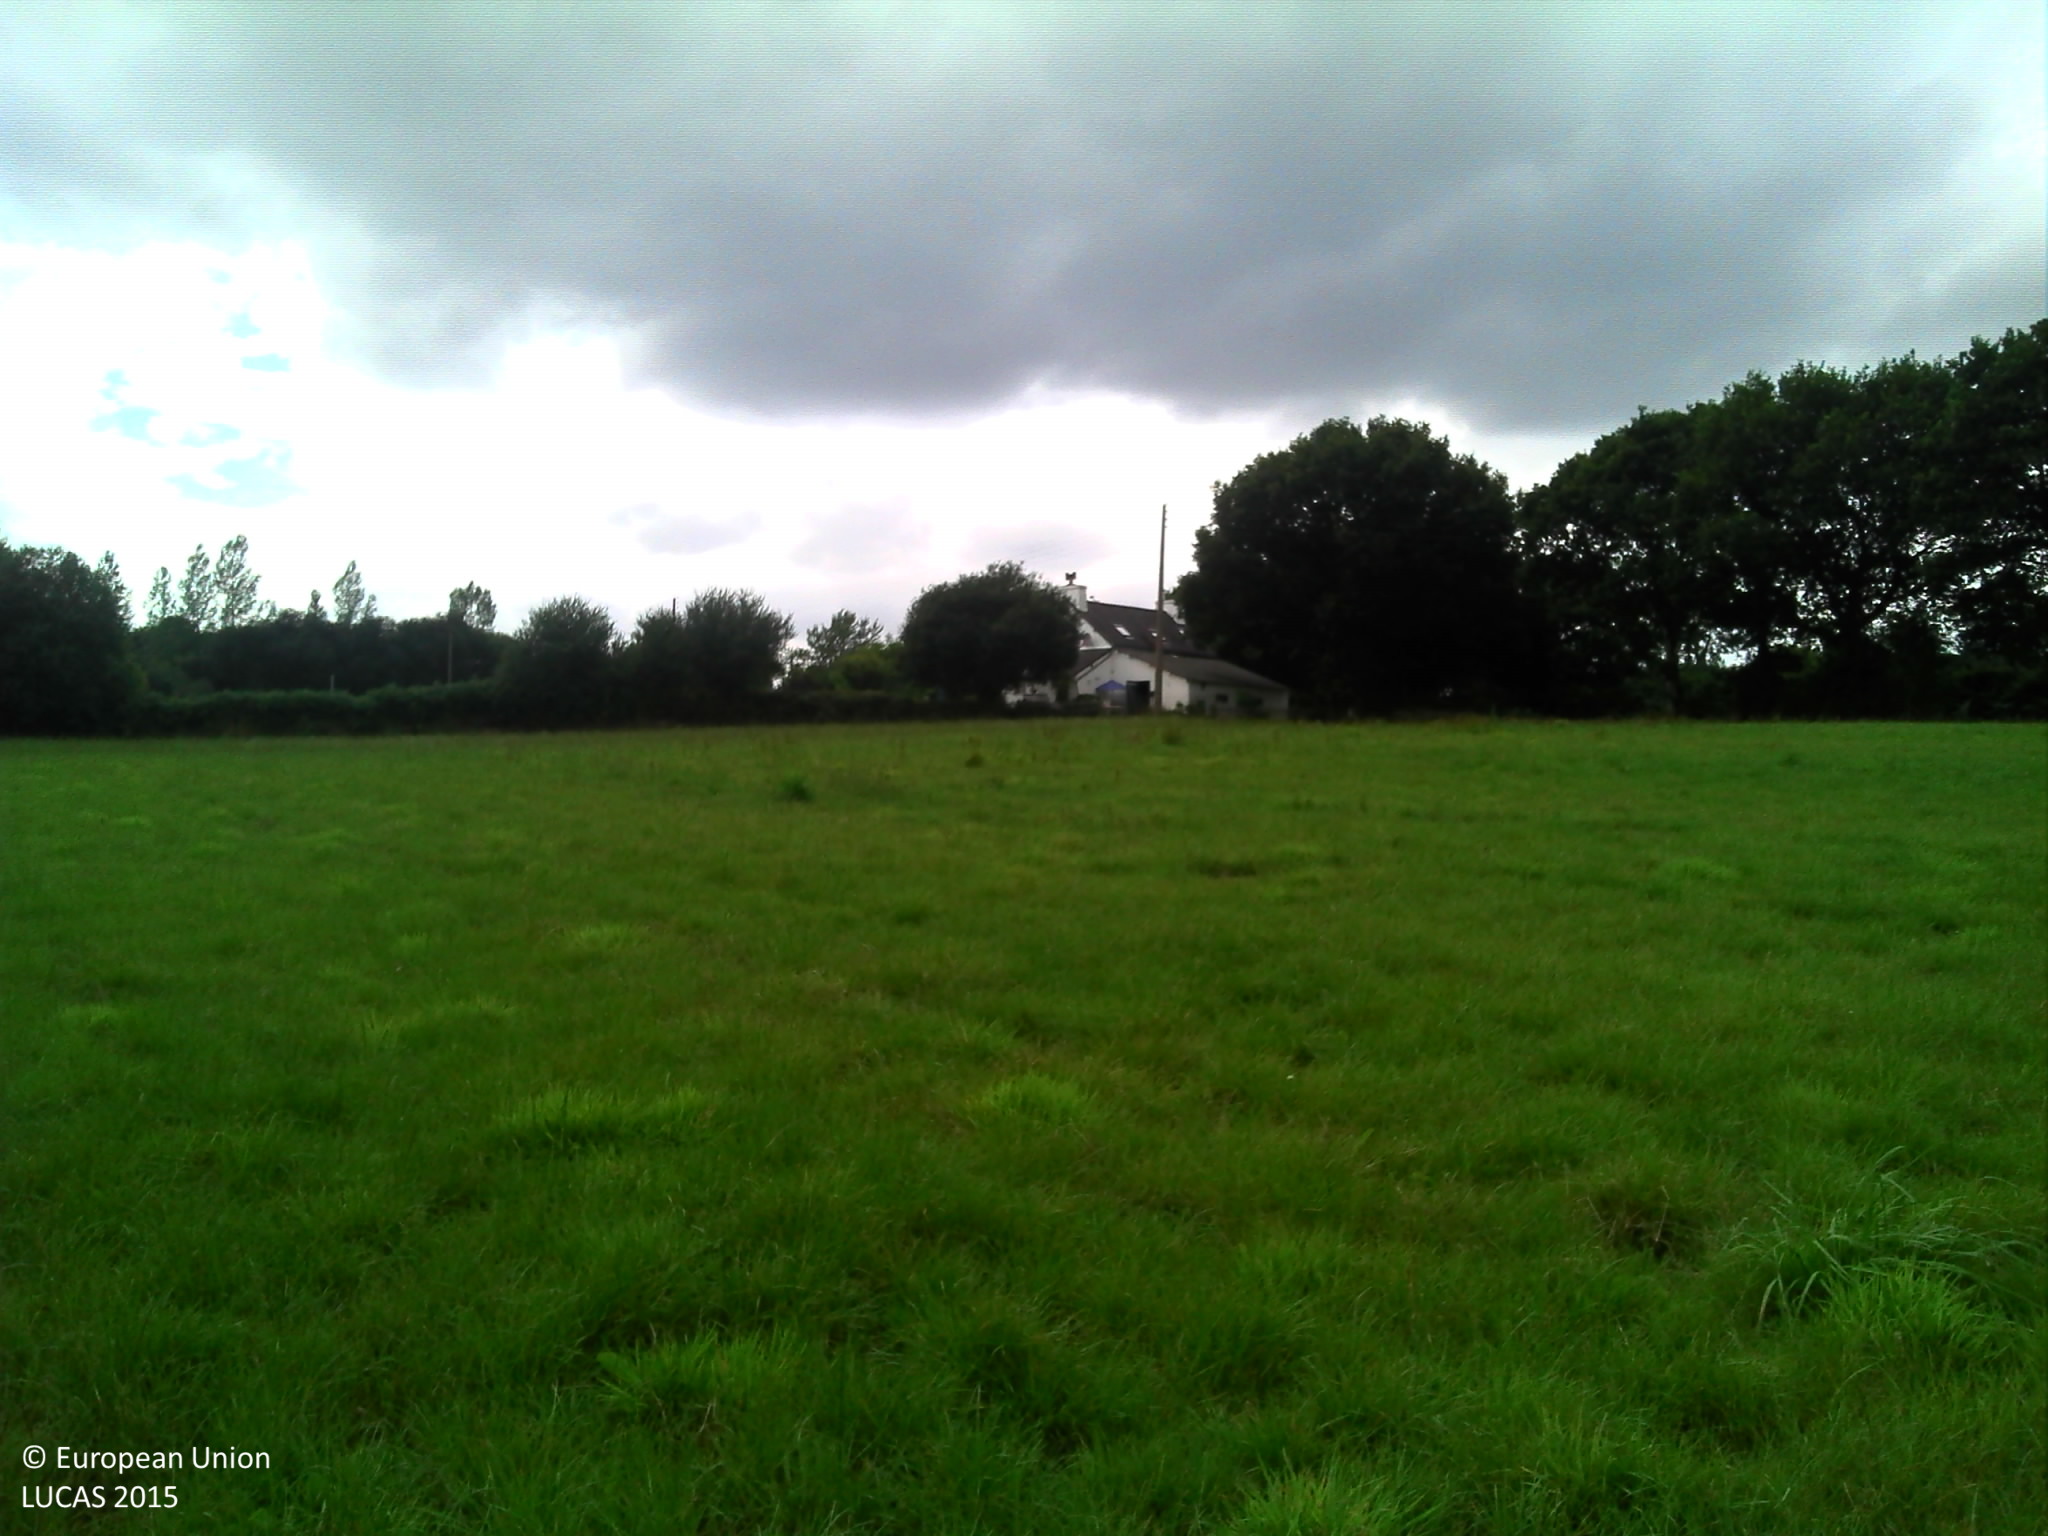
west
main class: Cropland
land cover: Temporary grasslands
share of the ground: > 75 %
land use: Agriculture (excluding fallow land and kitchen gardens)
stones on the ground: < 10 %
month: August
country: FR
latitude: 48.2937
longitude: -3.4072
